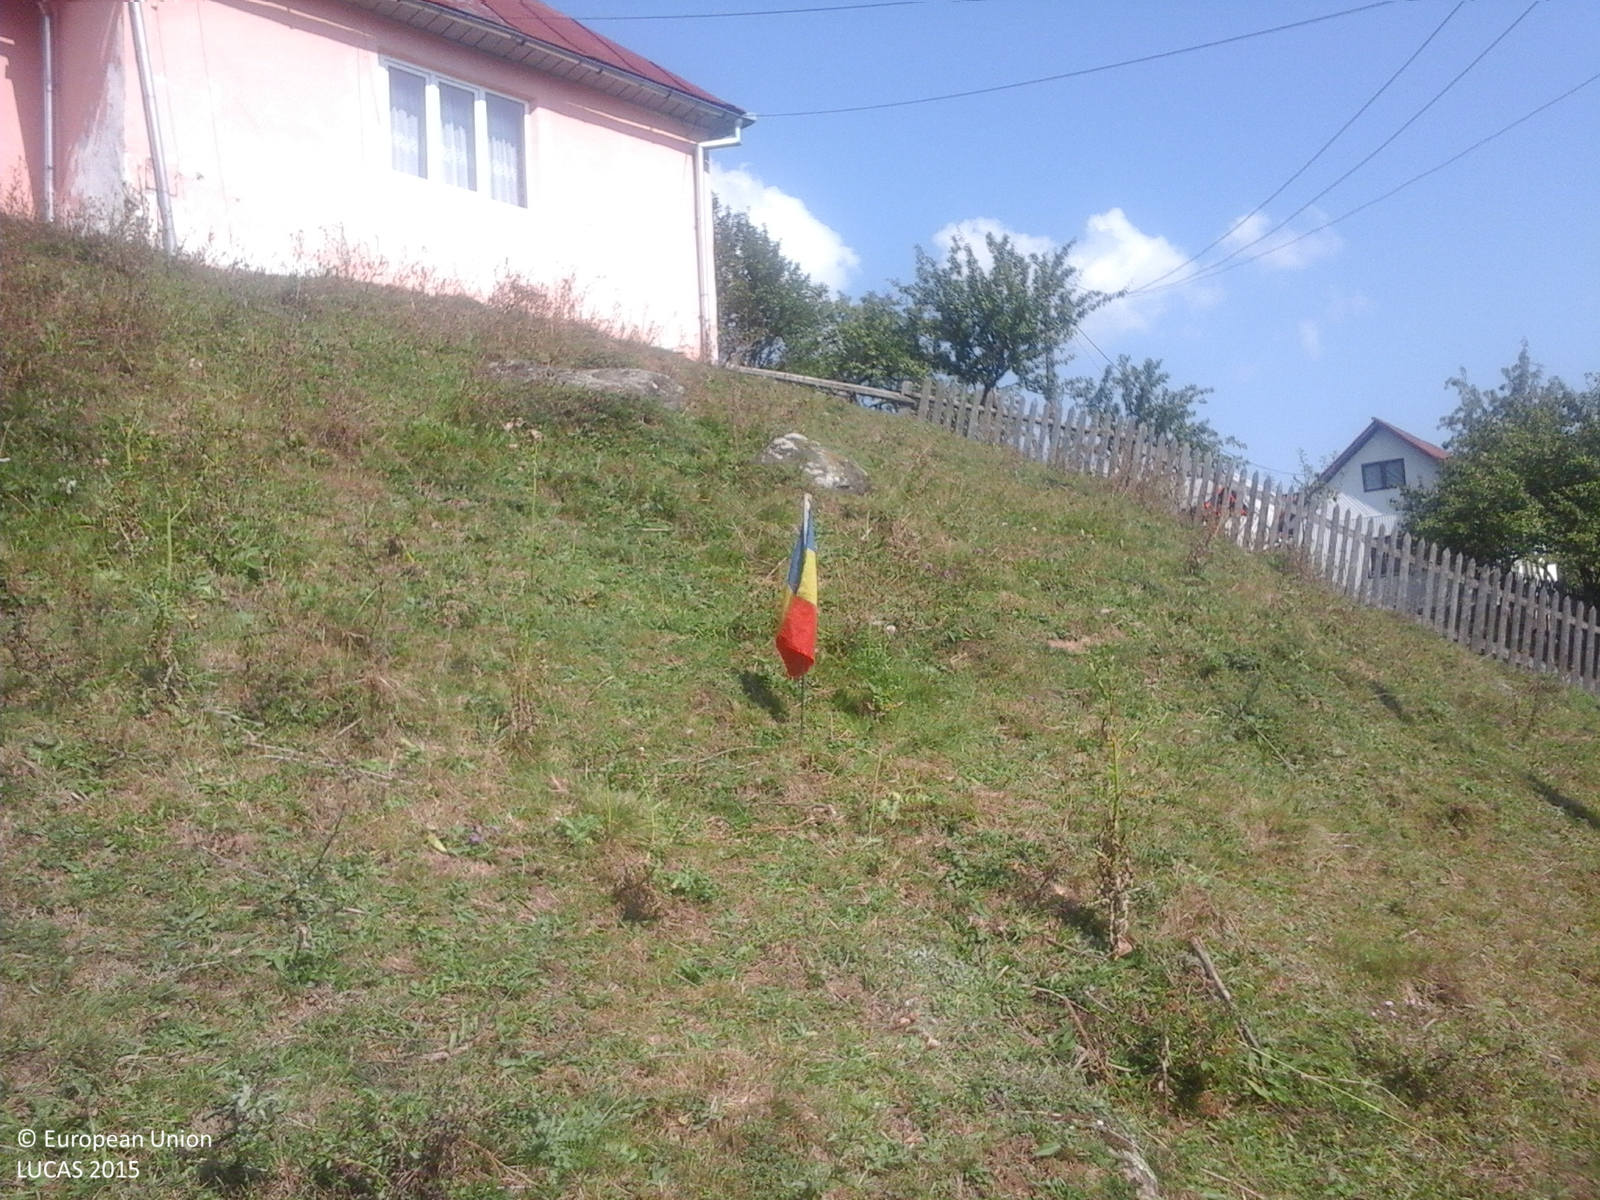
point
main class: Grassland
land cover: Grassland without tree/shrub cover
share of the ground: > 75 %
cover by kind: herbaceous plants 100 %
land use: Agriculture (excluding fallow land and kitchen gardens)
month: September
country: RO
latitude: 47.6373
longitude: 24.6723
